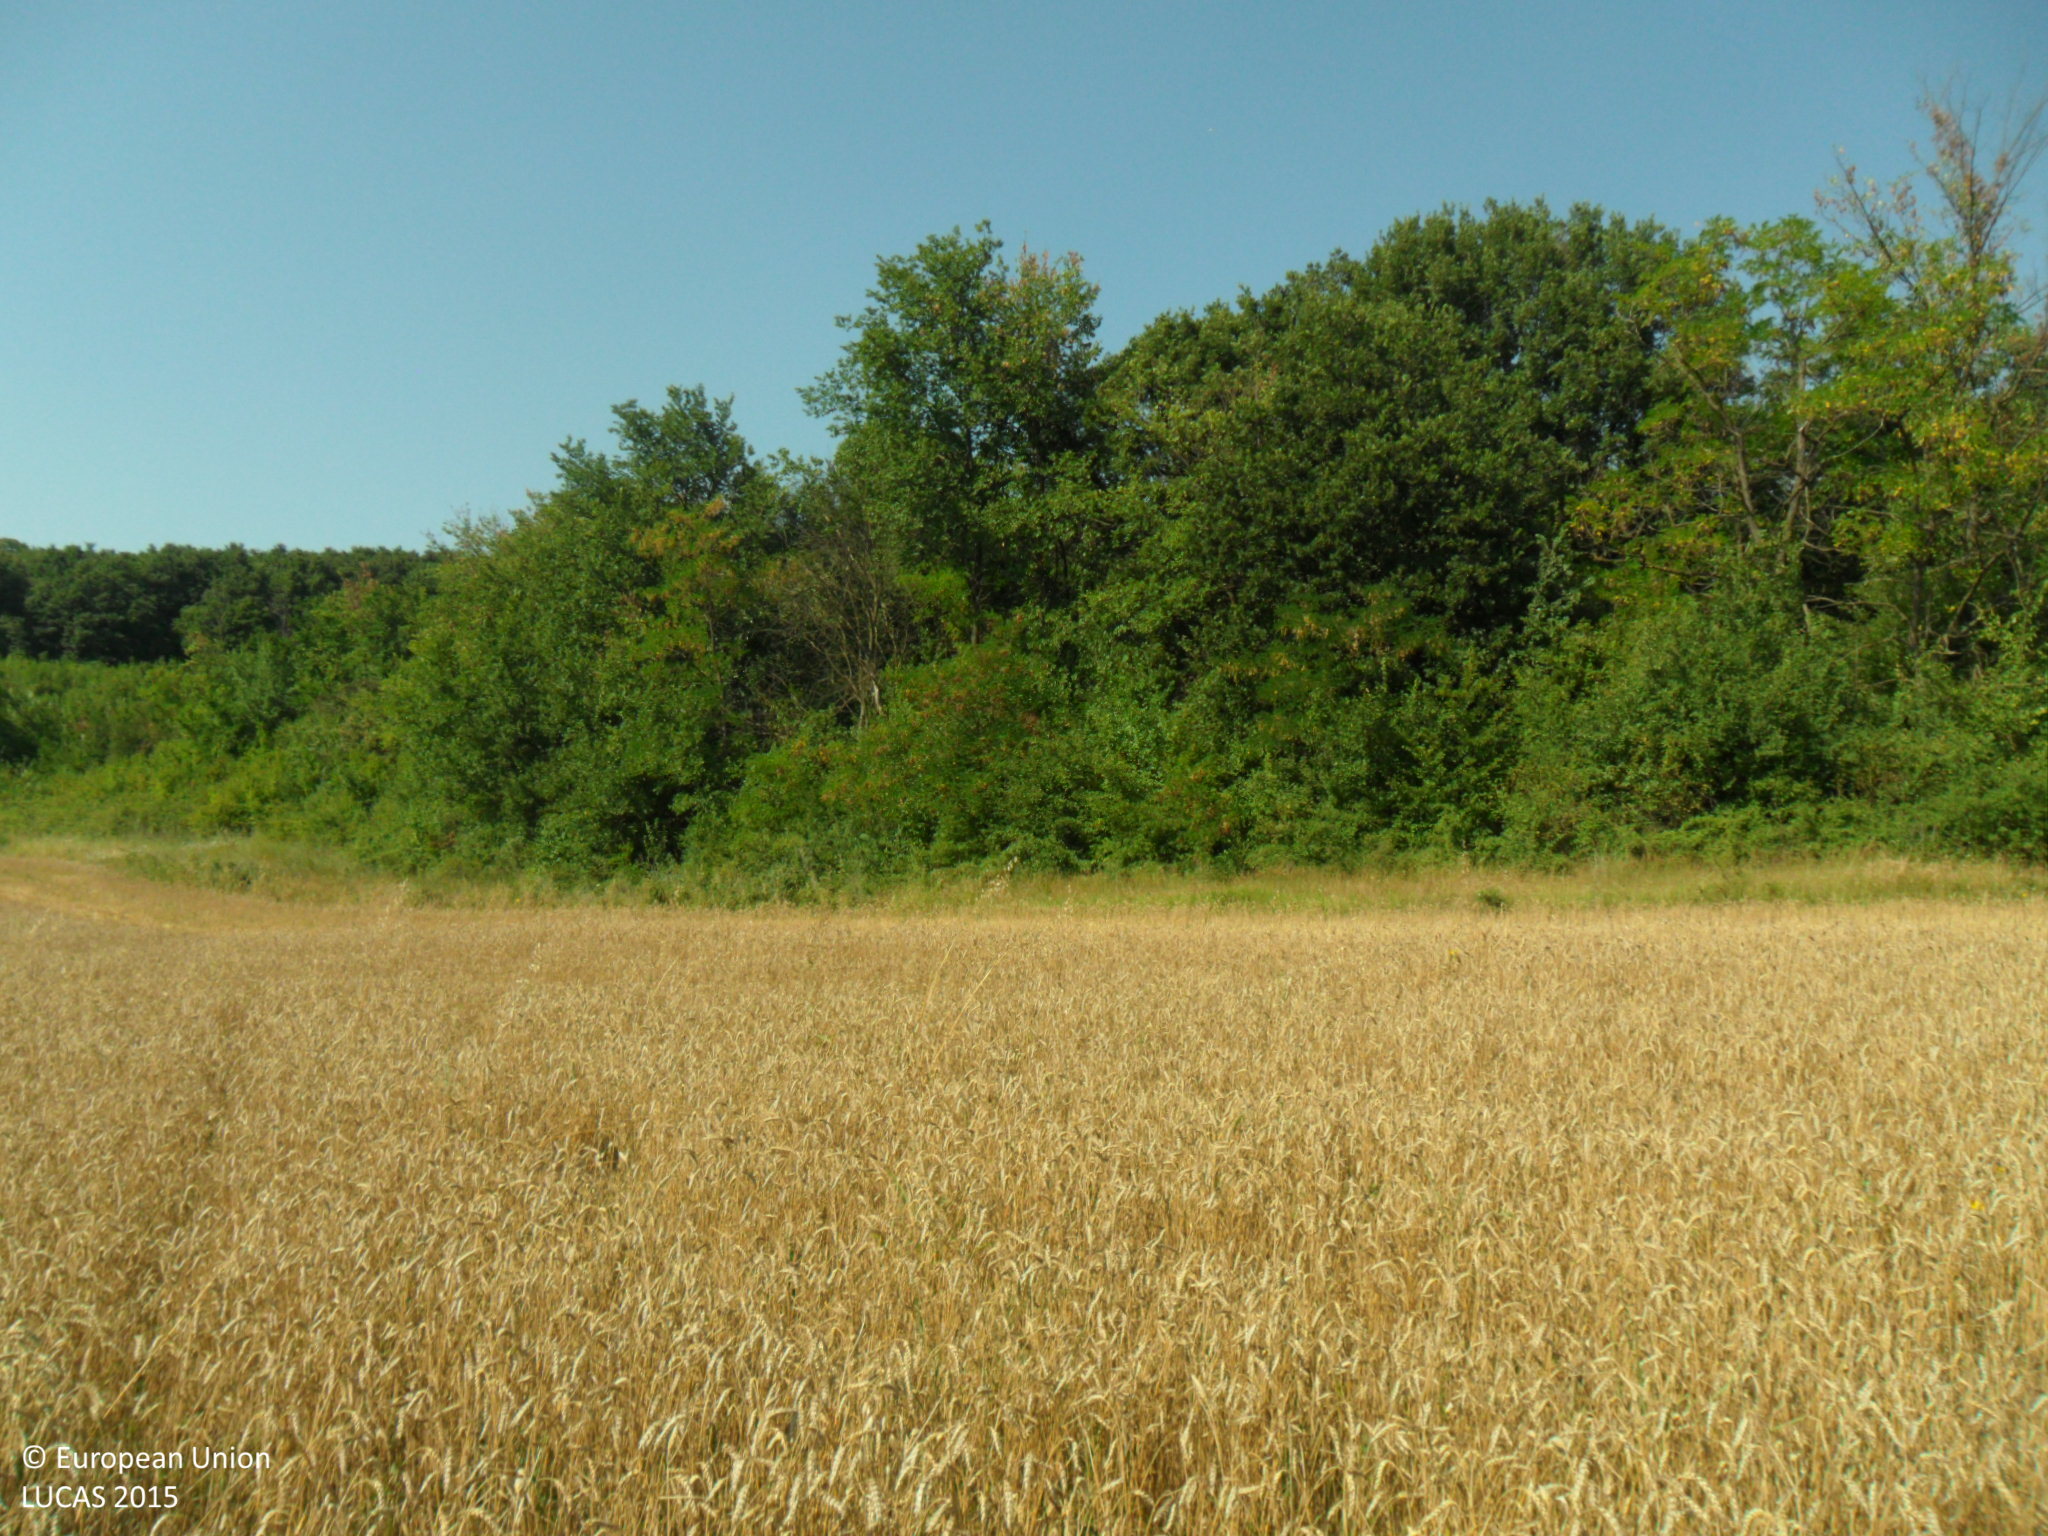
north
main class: Cropland
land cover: Common wheat
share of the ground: > 75 %
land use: Agriculture (excluding fallow land and kitchen gardens)
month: July
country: BG
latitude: 43.3945
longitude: 26.5621
